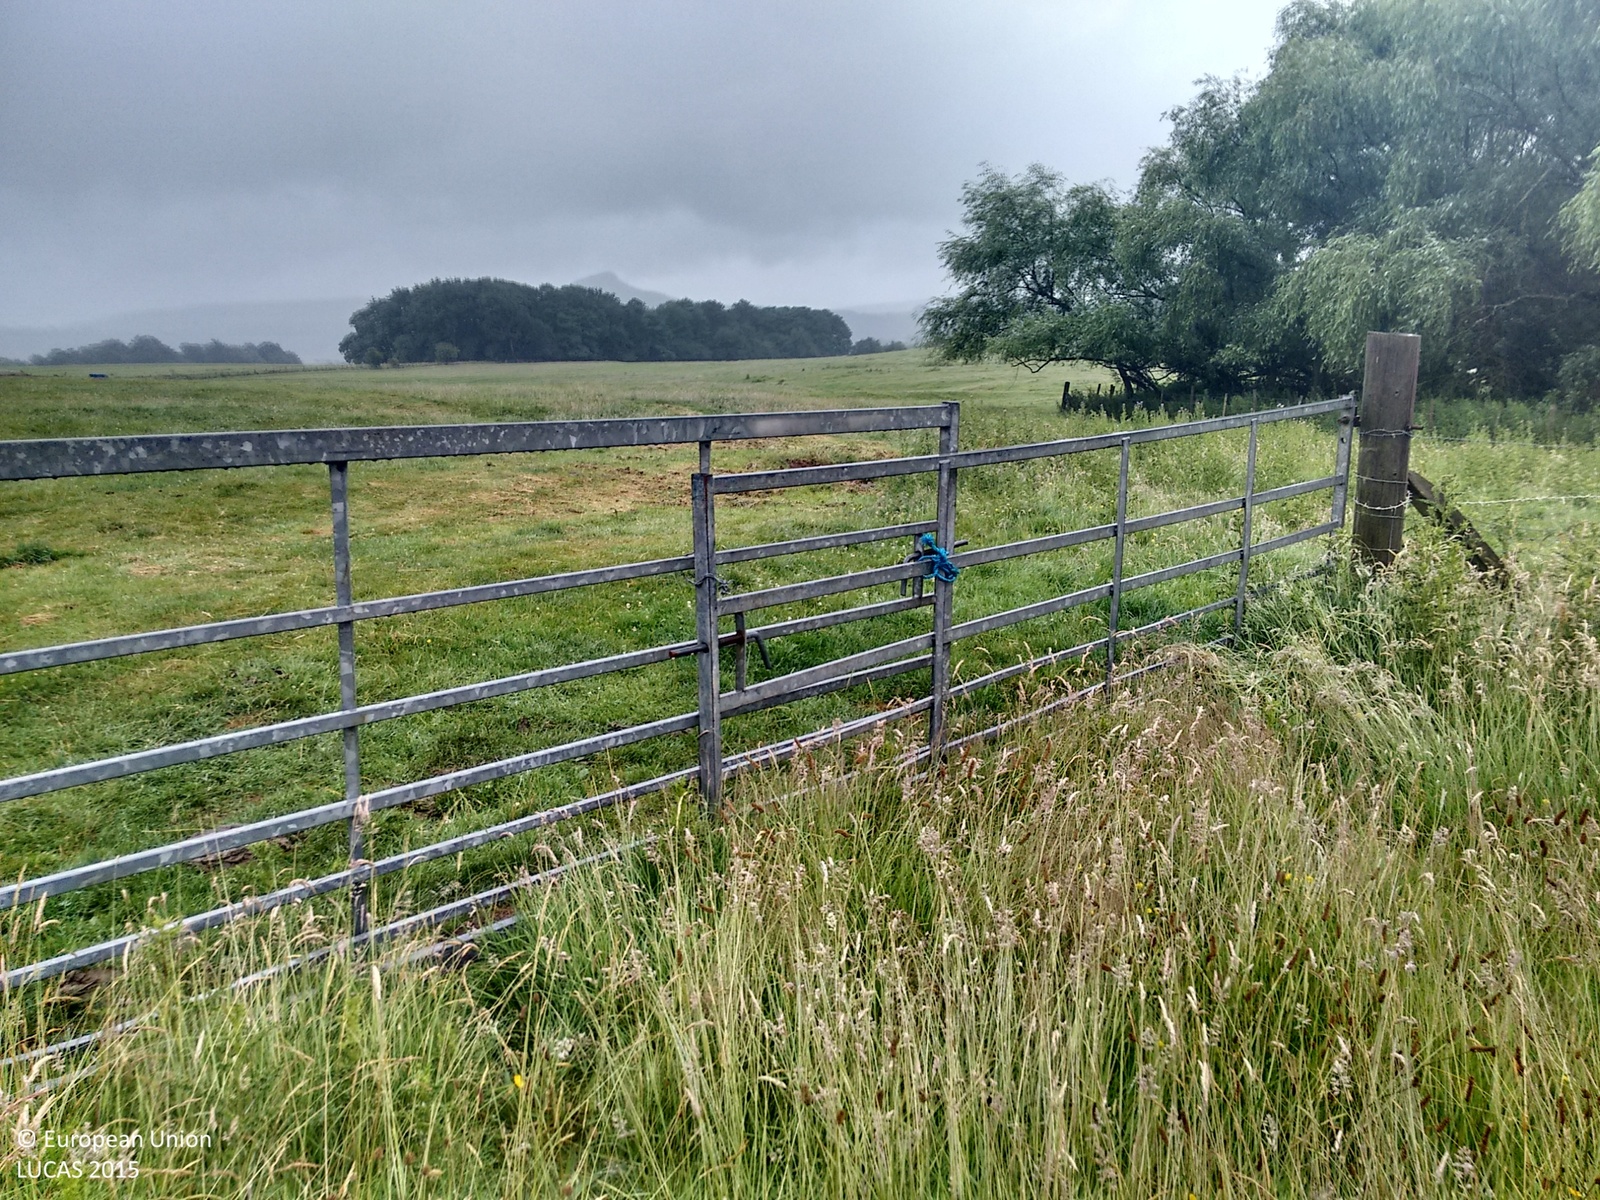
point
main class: Grassland
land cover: Grassland without tree/shrub cover
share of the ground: > 75 %
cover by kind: herbaceous plants 100 %
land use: Agriculture (excluding fallow land and kitchen gardens)
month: July
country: GB
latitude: 54.5194
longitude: -1.1513
